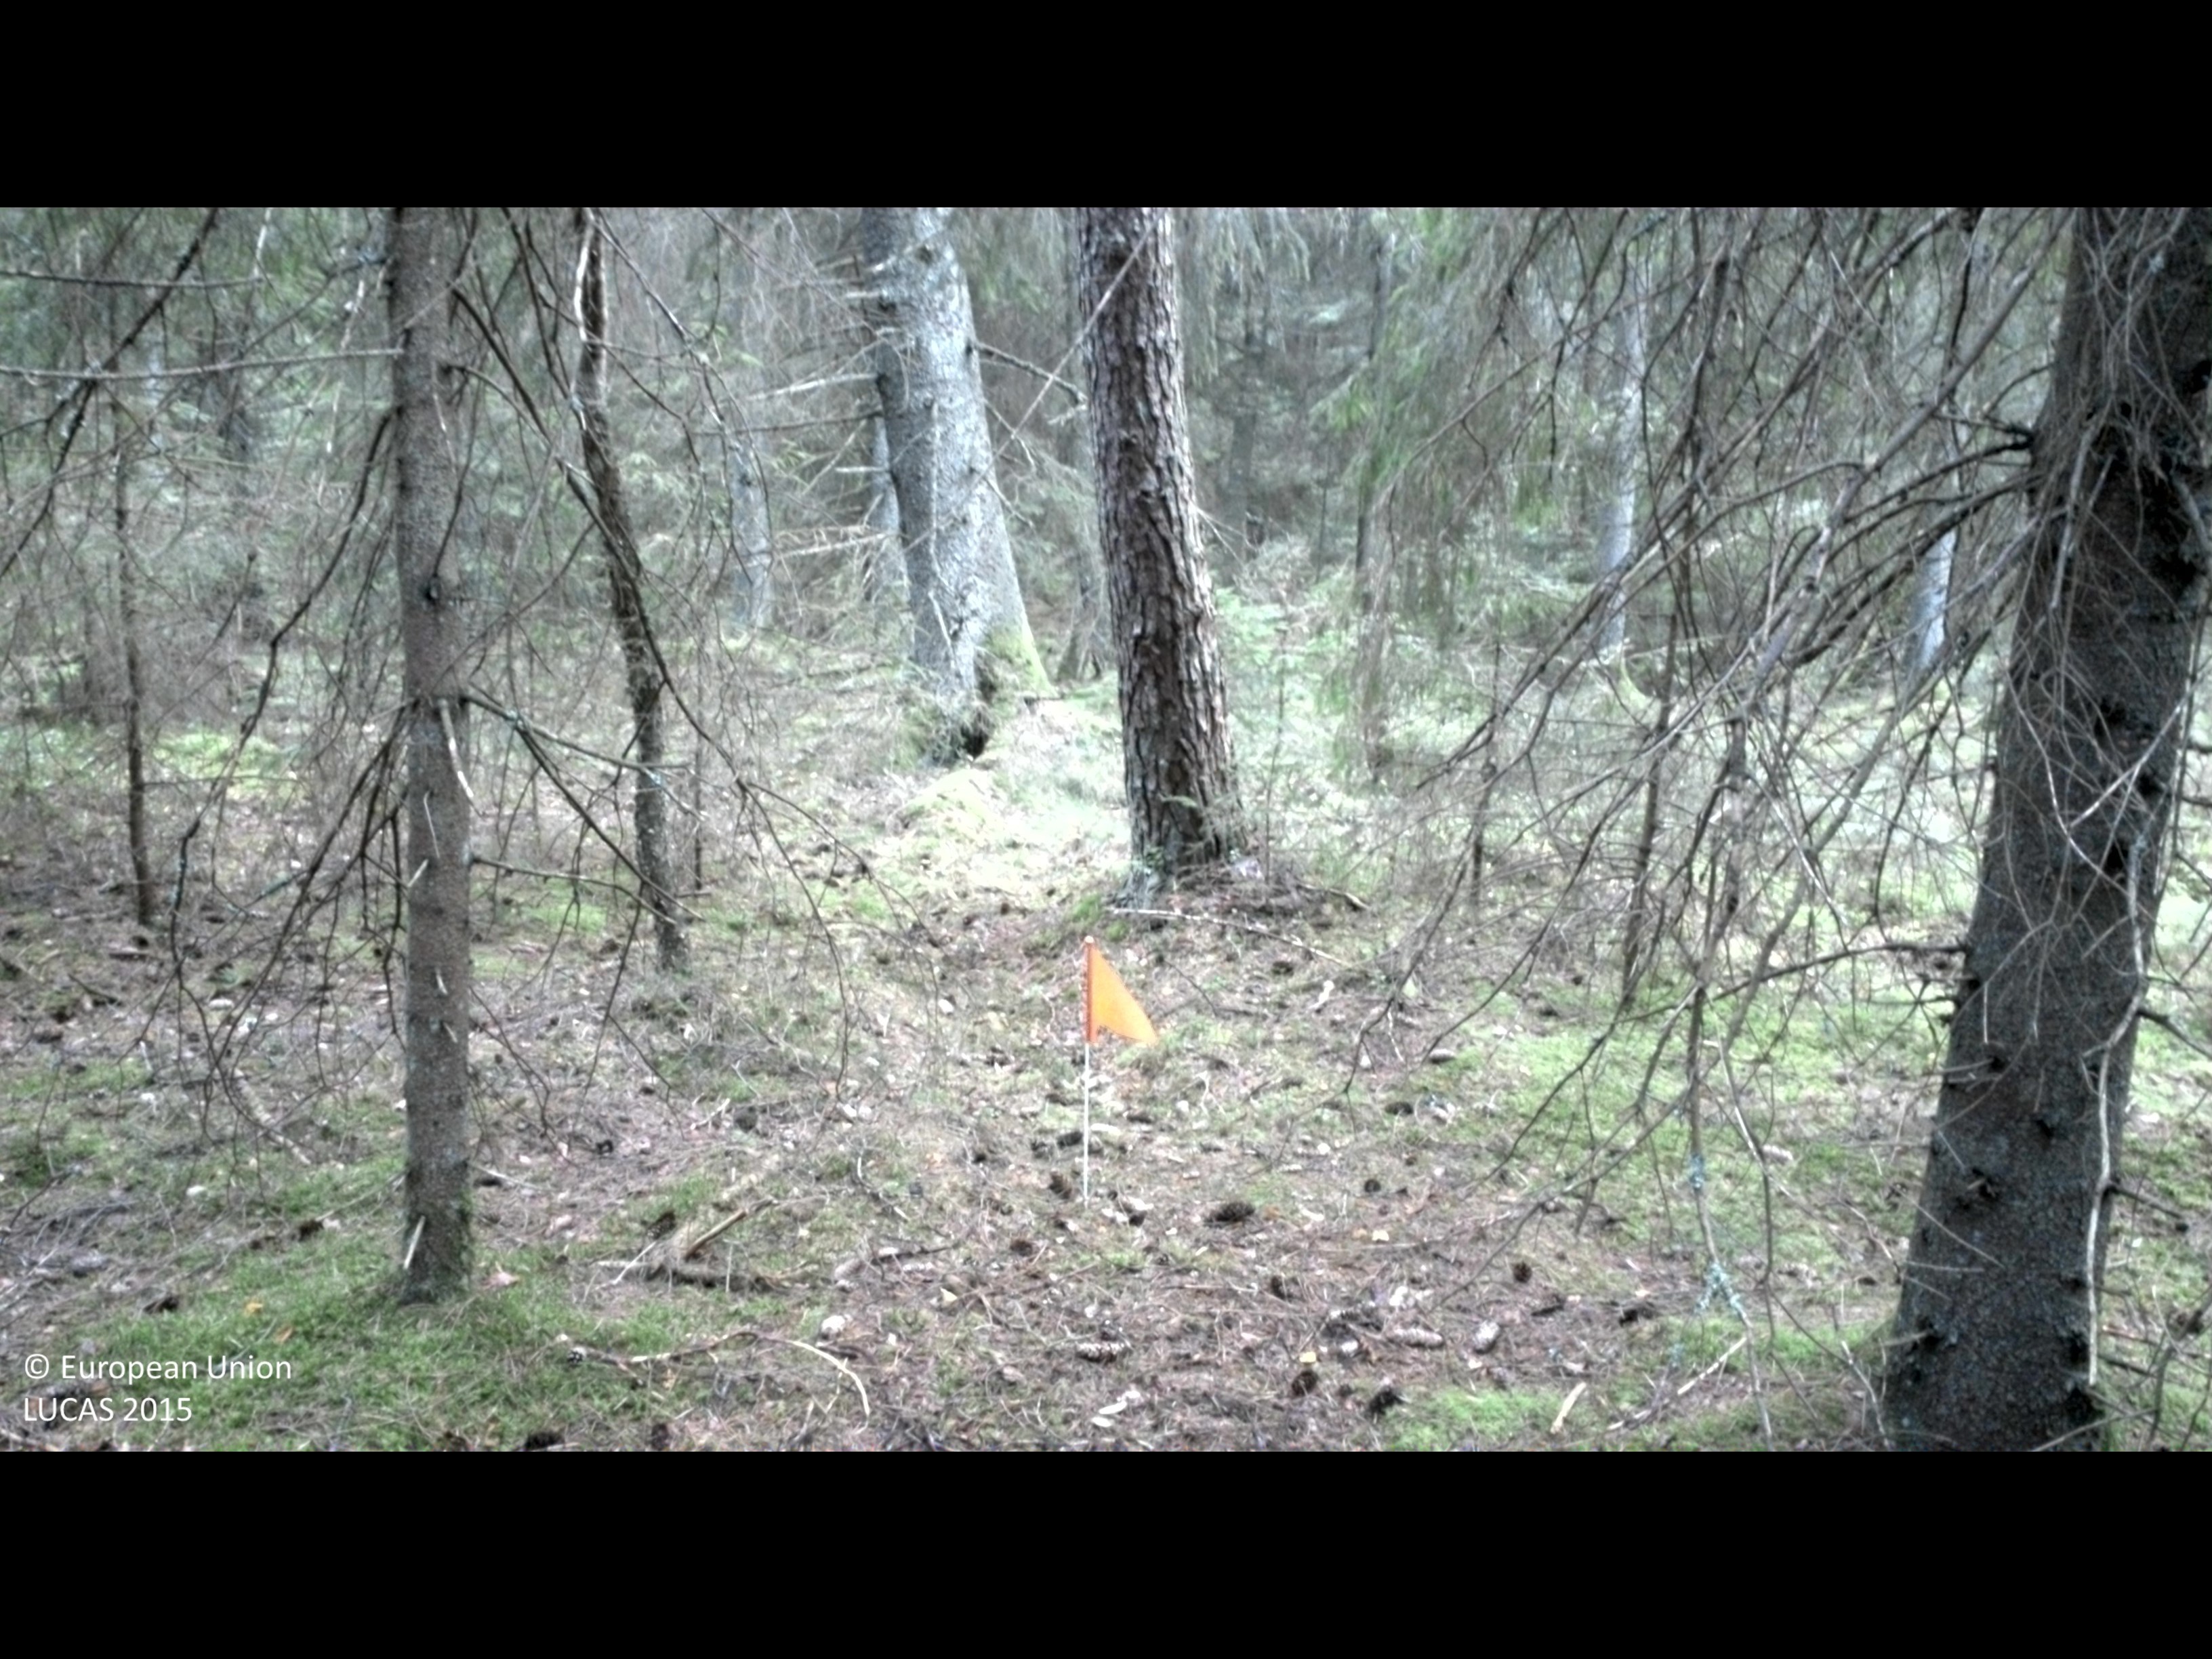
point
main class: Woodland
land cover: Spruce dominated coniferous woodland
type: boreal forest
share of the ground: > 75 %
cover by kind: coniferous forest trees 75 %, shrubs 15 %, broadleaved forest trees 5 %, lichens and mosses 5 %
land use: Forestry
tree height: > 5 m
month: August
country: SE
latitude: 56.9404
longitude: 13.1687
